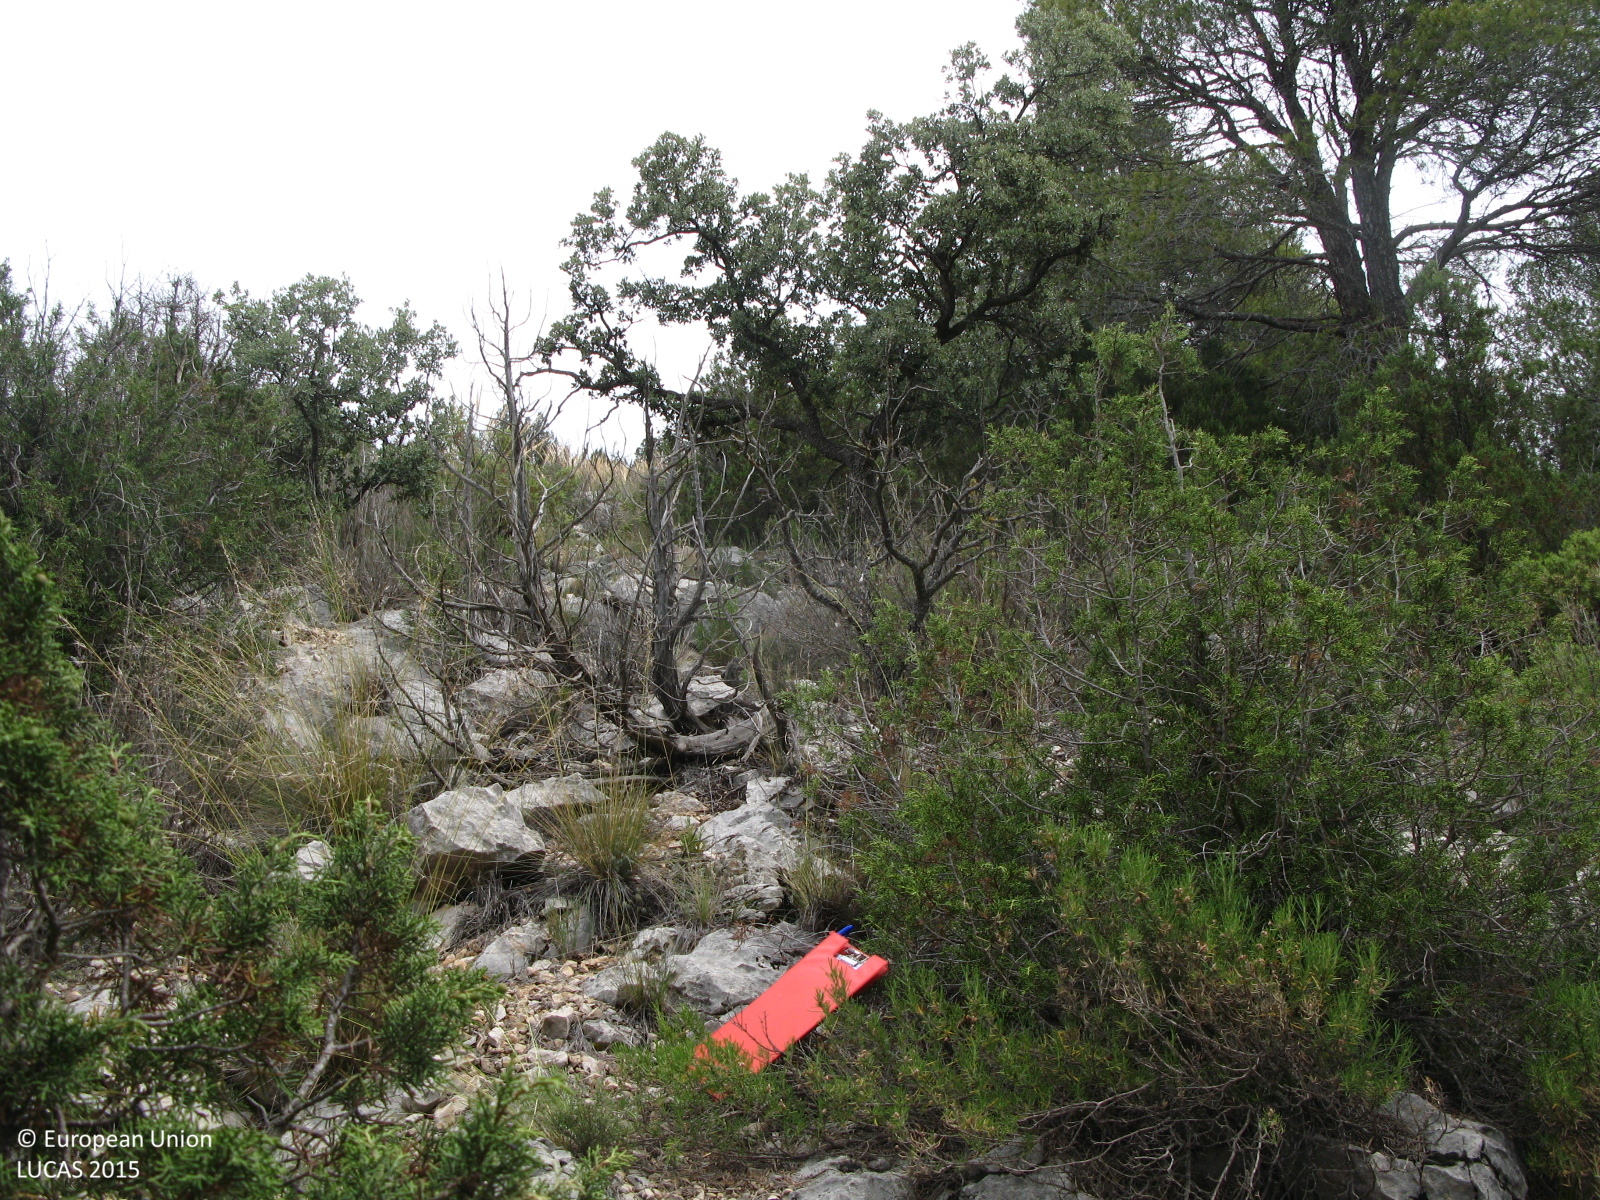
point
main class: Woodland
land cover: Pine dominated coniferous woodland
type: coniferous forest of the mediterranean region
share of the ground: 10 - 25 %
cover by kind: consolidated bare surface 40 %, shrubs 25 %, coniferous forest trees 15 %, herbaceous plants 15 %, broadleaved forest trees 5 %
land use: Forestry
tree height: > 5 m
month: June
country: ES
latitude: 39.9541
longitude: -1.1857
